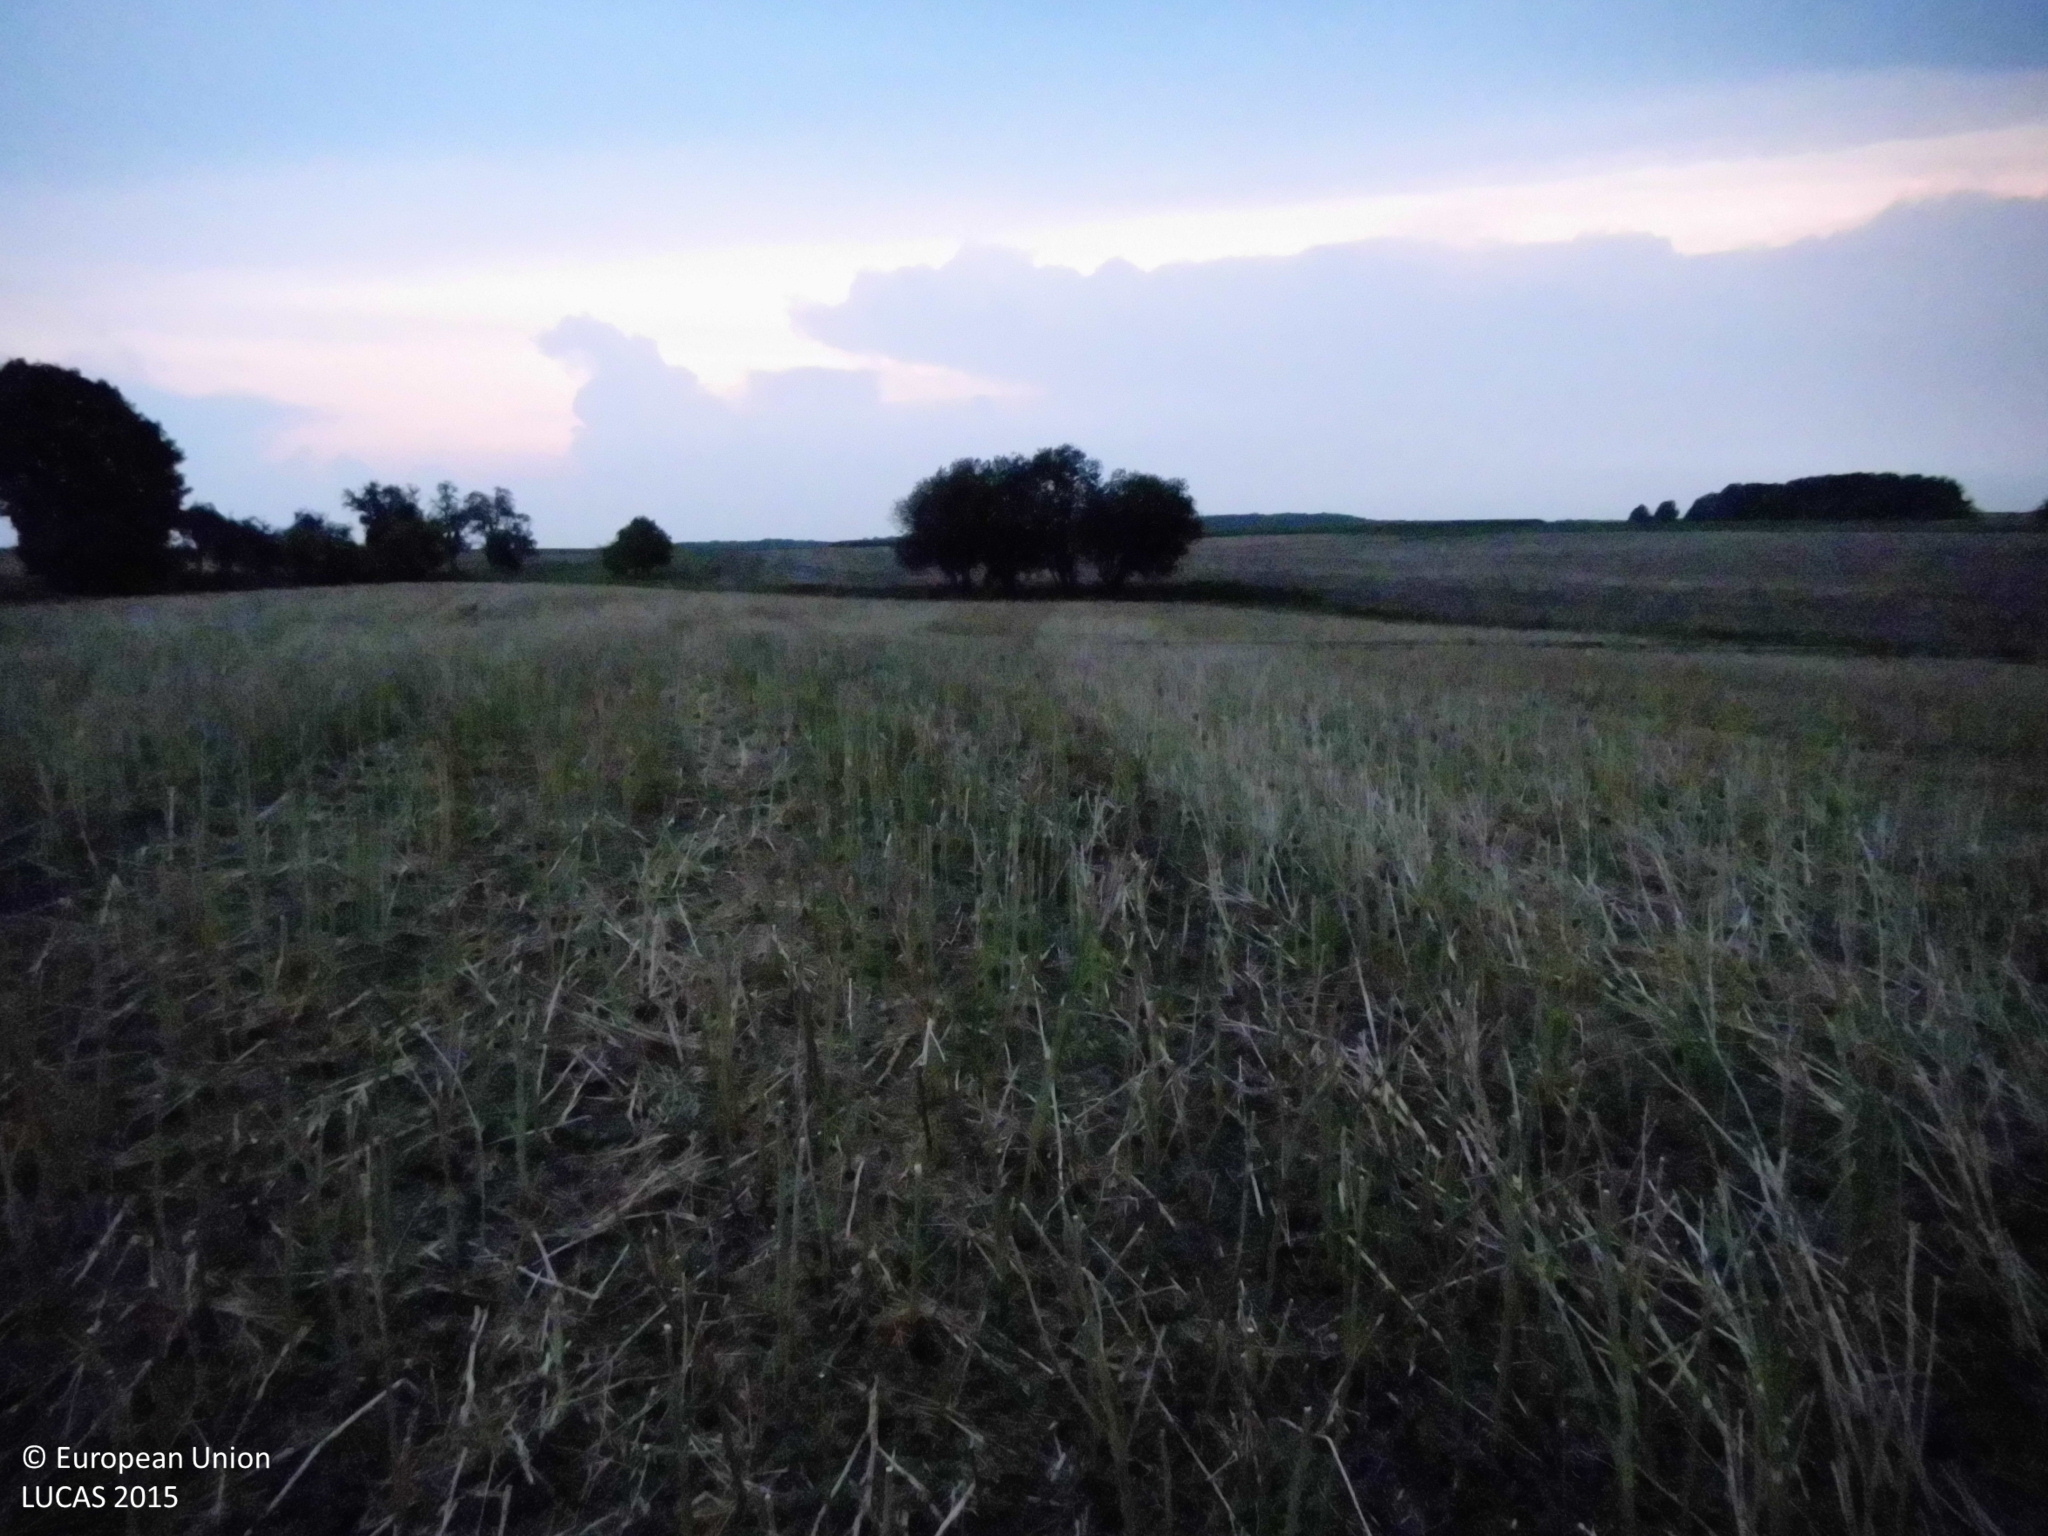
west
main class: Cropland
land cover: Rape and turnip rape
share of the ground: > 75 %
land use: Agriculture (excluding fallow land and kitchen gardens)
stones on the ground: < 10 %
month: August
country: DE
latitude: 50.5354
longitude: 8.6036
